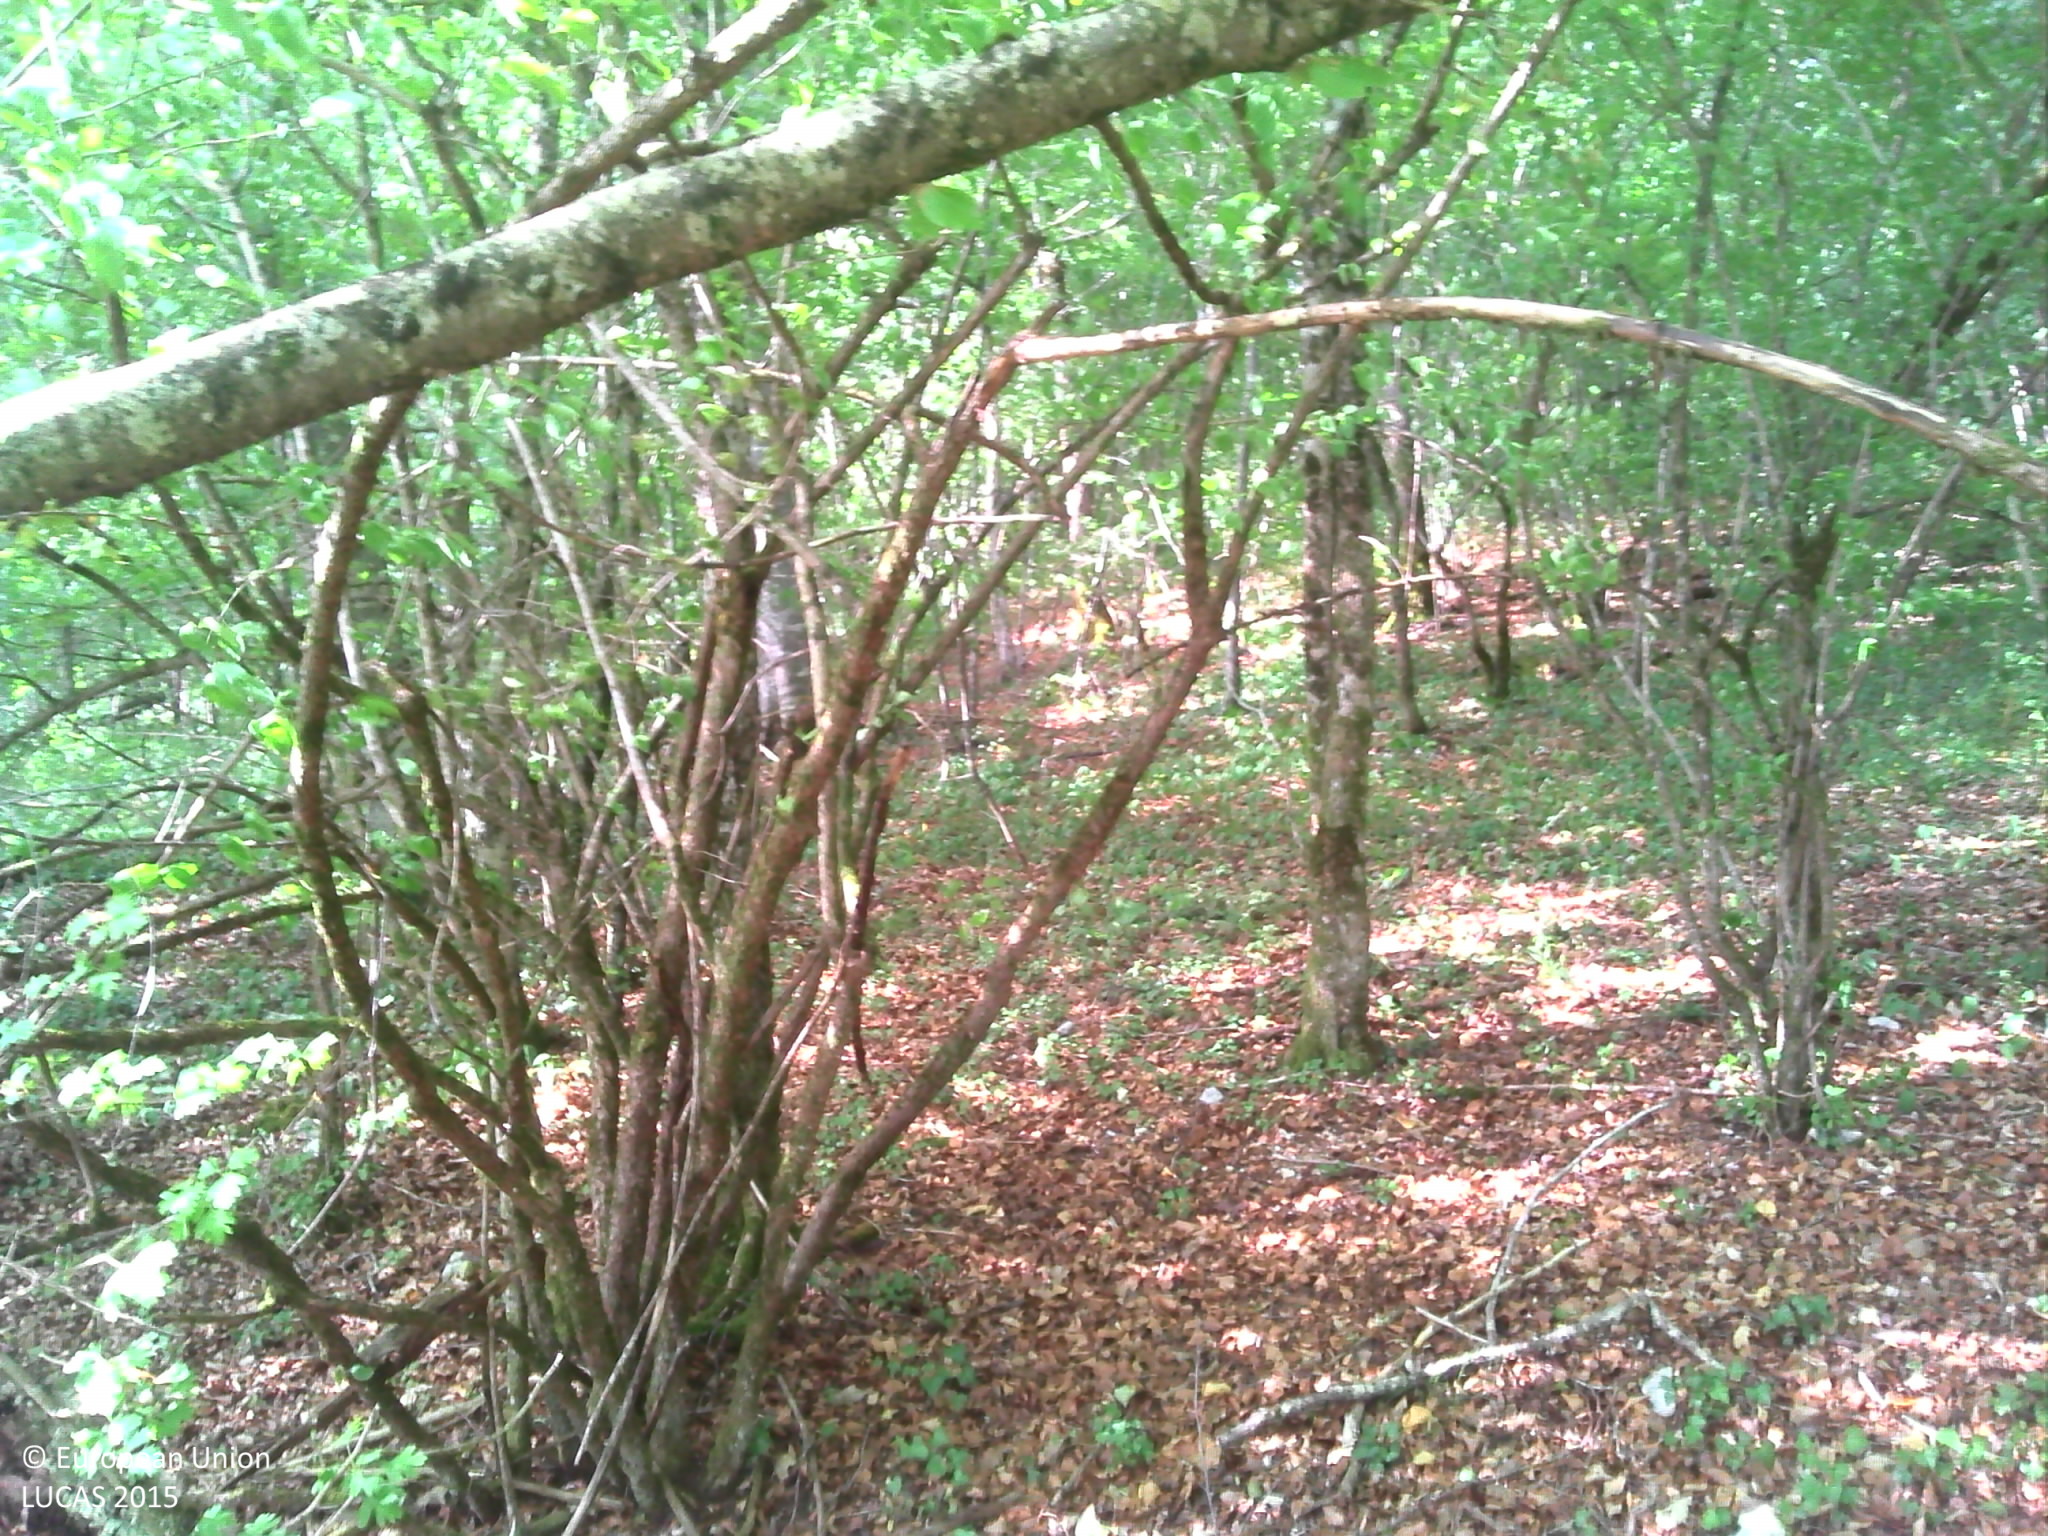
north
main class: Woodland
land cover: Broadleaved woodland
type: acidophilous oak and oak-birch forest
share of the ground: > 75 %
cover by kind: broadleaved forest trees 85 %, coniferous forest trees 5 %, herbaceous plants 5 %, lichens and mosses 5 %
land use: Forestry
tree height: > 5 m
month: July
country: FR
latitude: 47.8918
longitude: 4.9570
